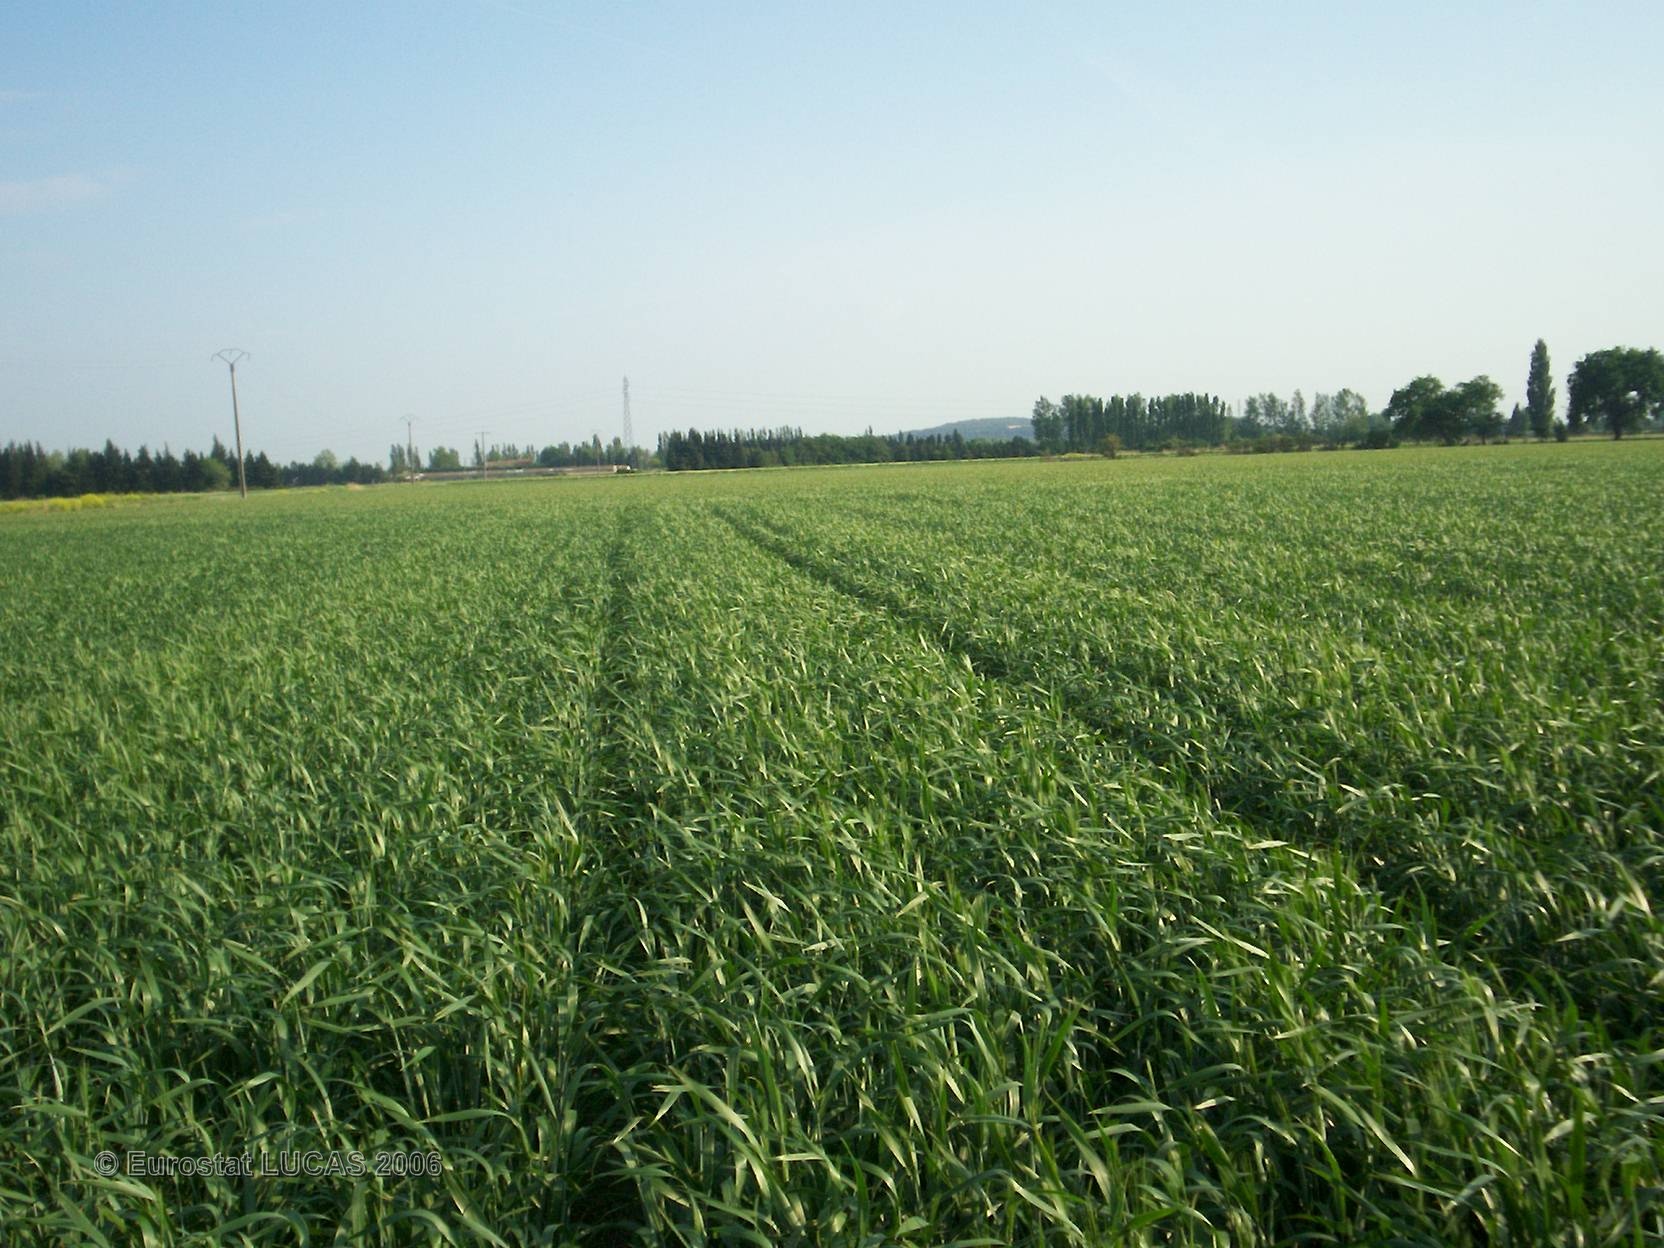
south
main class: Cropland
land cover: Durum wheat
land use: Agriculture (excluding fallow land and kitchen gardens)
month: May
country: FR
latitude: 44.0626
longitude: 4.9023
